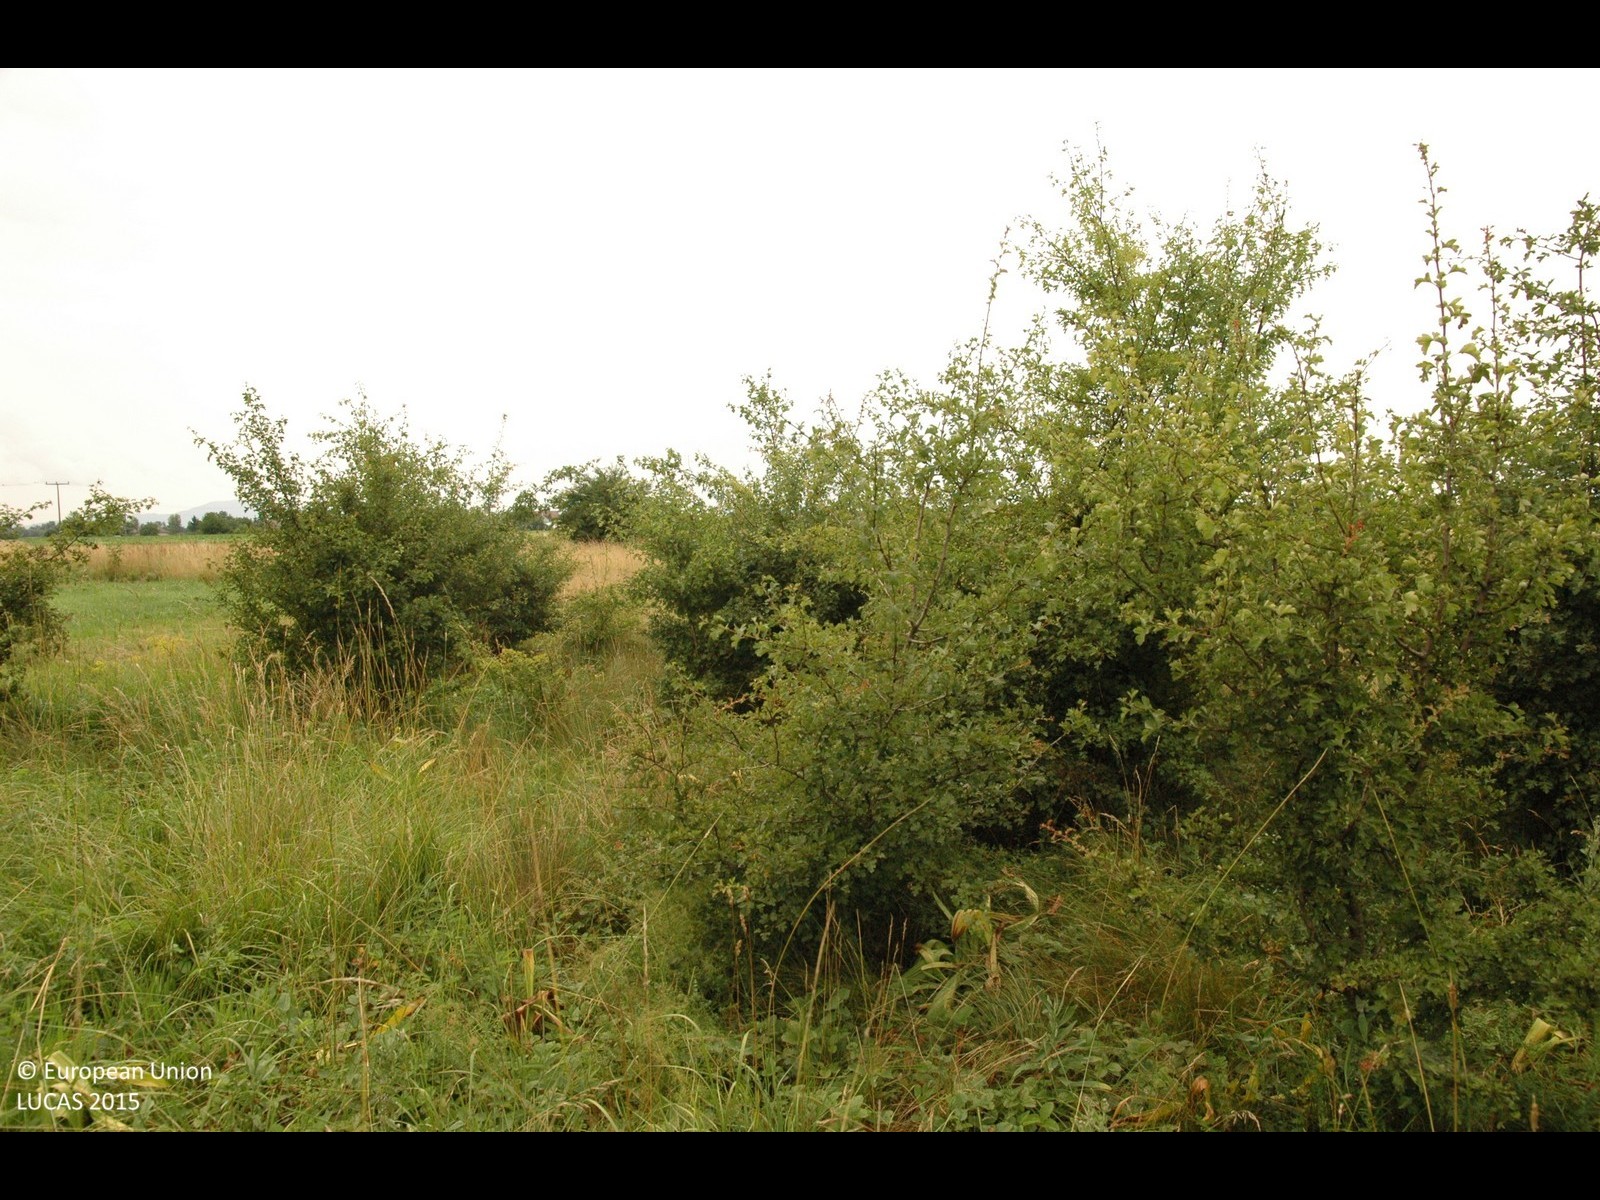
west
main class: Grassland
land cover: Grassland with sparse tree/shrub cover
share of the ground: > 75 %
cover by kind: herbaceous plants 85 %, shrubs 10 %, broadleaved forest trees 5 %
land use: Abandoned areas
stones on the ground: < 10 %
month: June
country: HR
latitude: 46.3788
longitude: 16.3581
